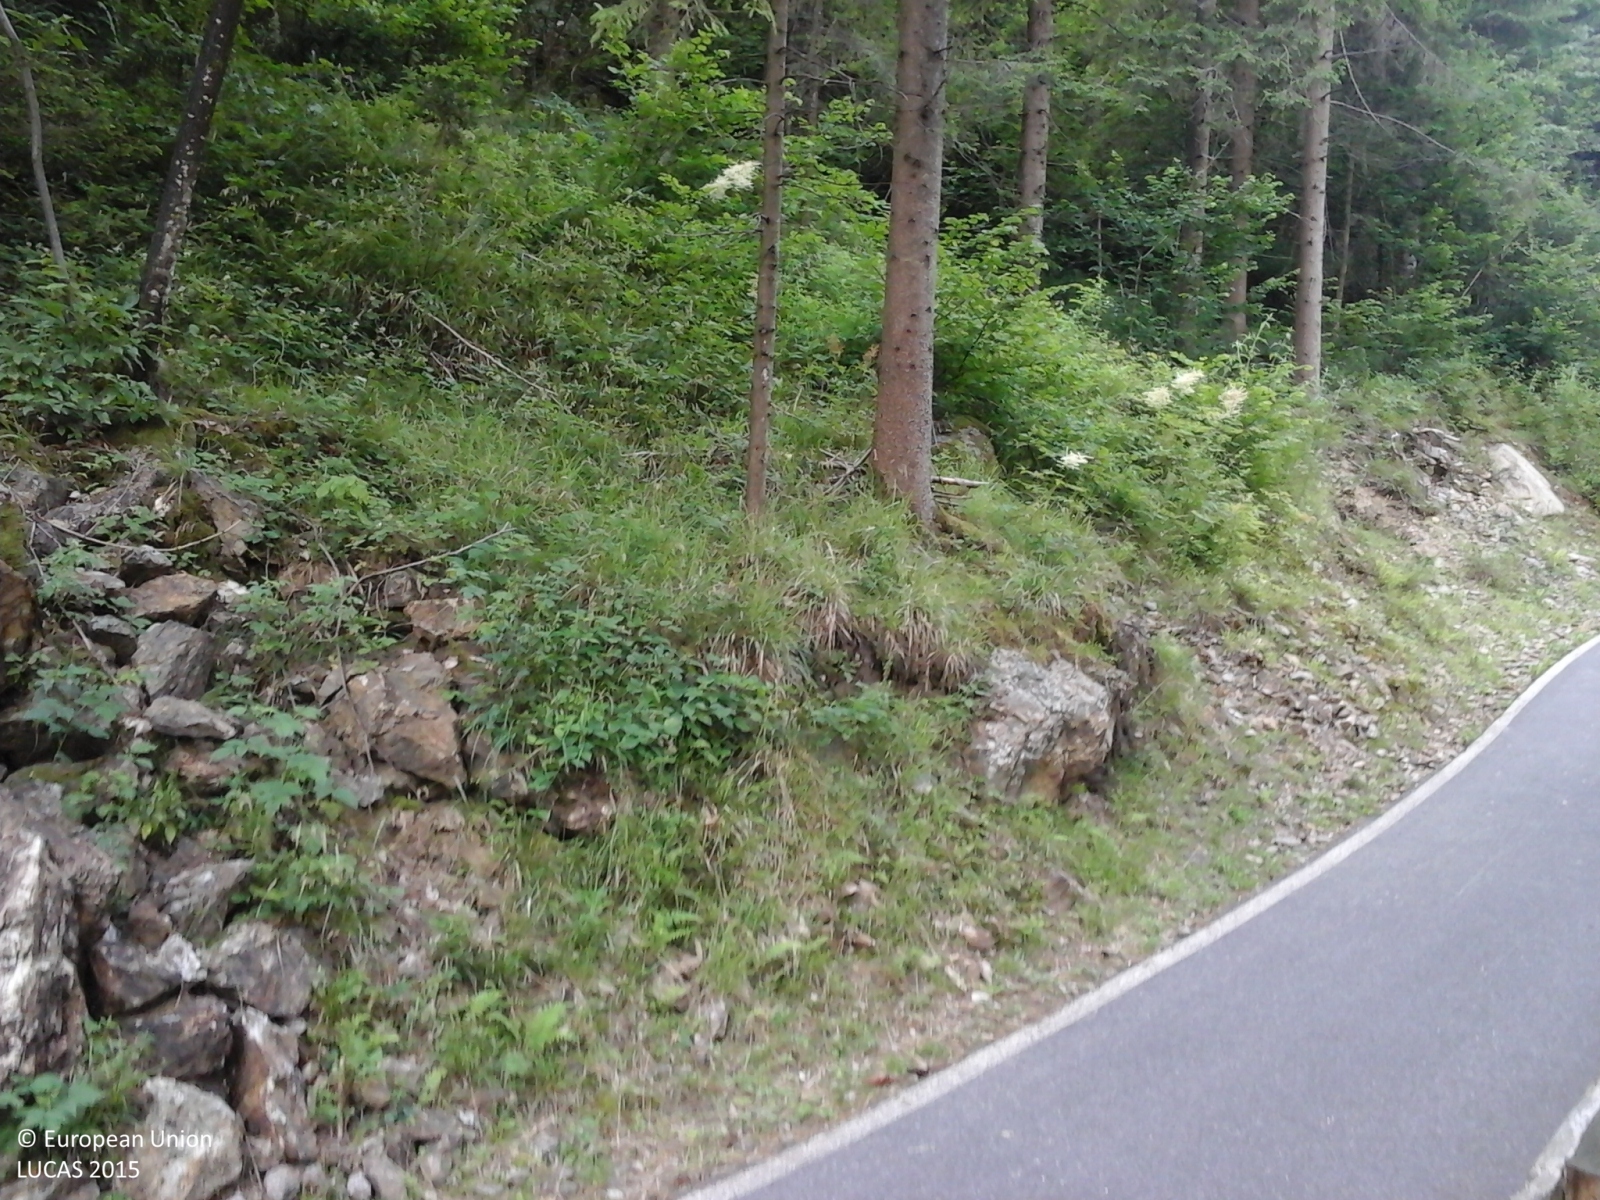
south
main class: Woodland
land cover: Spruce dominated coniferous woodland
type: alpine coniferous forest
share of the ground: > 75 %
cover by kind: coniferous forest trees 80 %, broadleaved forest trees 20 %
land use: Semi-natural and natural areas not in use
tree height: > 5 m
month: July
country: IT
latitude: 45.9729
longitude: 9.9356
